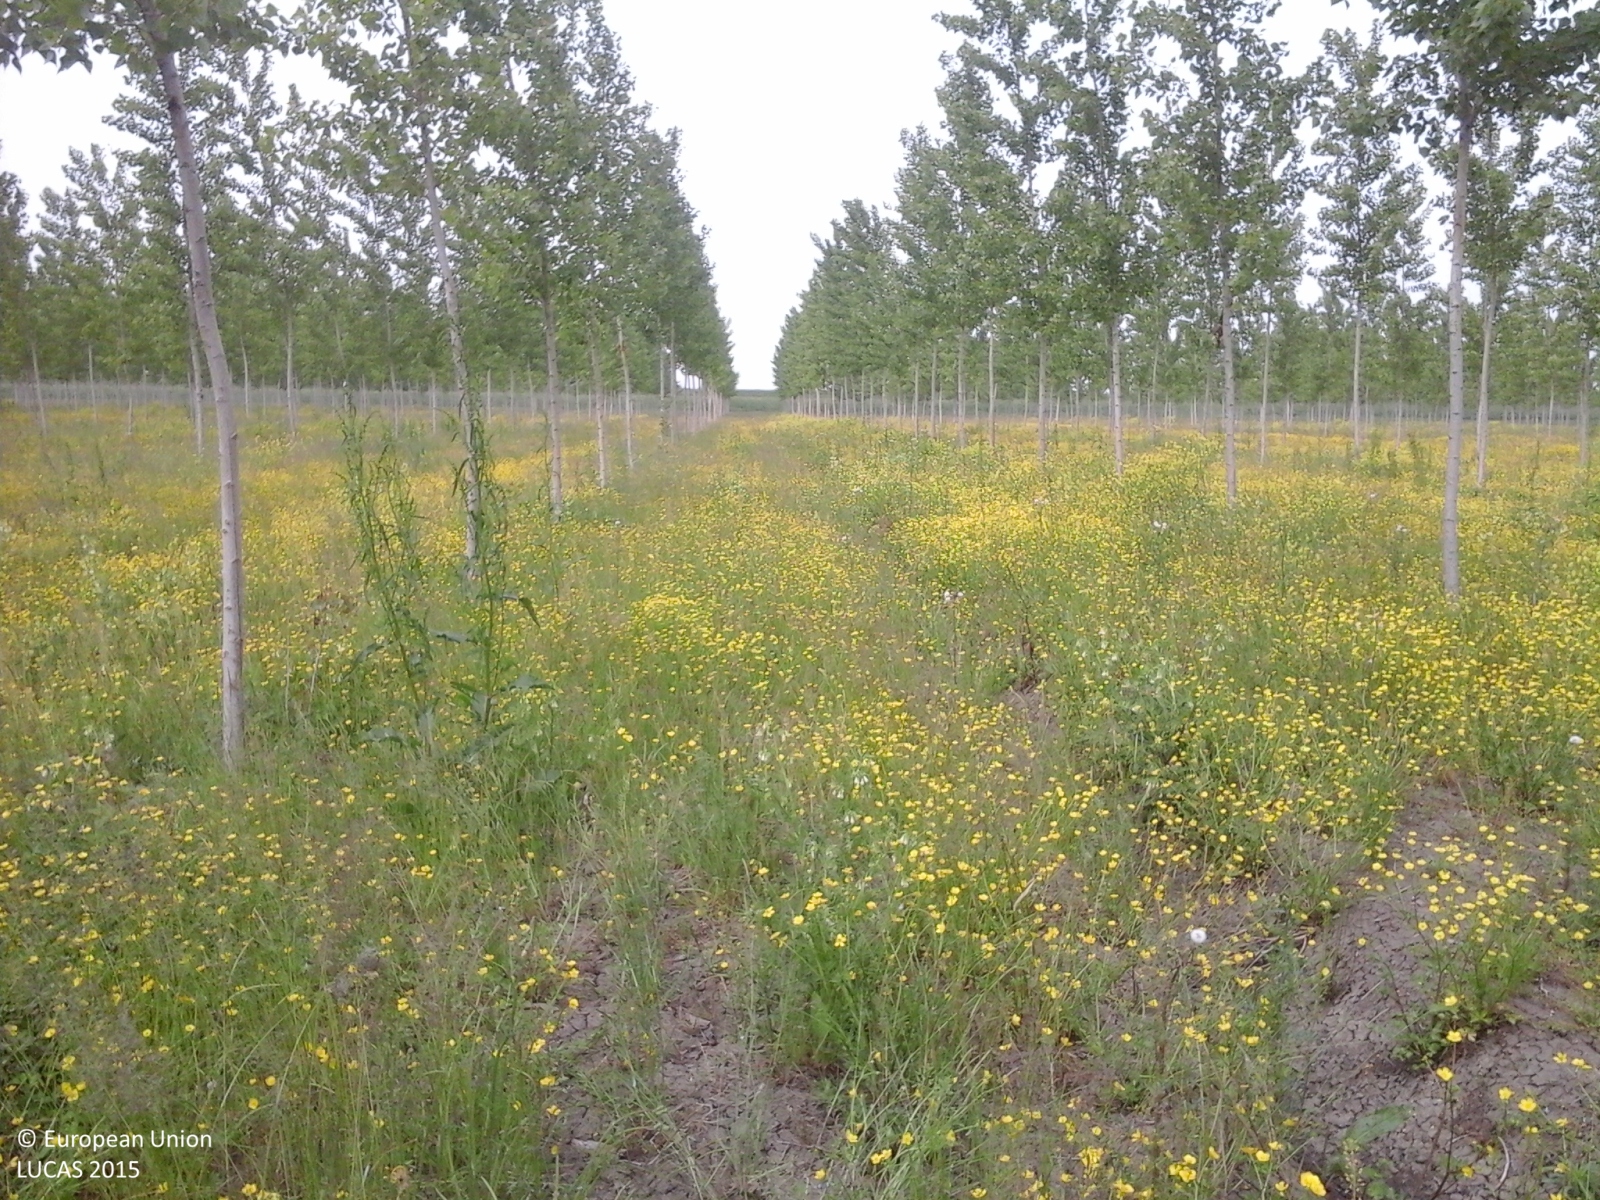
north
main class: Woodland
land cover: Broadleaved woodland
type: non-riverine alder, birch or aspen forest
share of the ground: 10 - 25 %
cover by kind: herbaceous plants 80 %, broadleaved forest trees 20 %
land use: Forestry
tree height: > 5 m
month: May
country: IT
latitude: 44.8892
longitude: 10.6950
